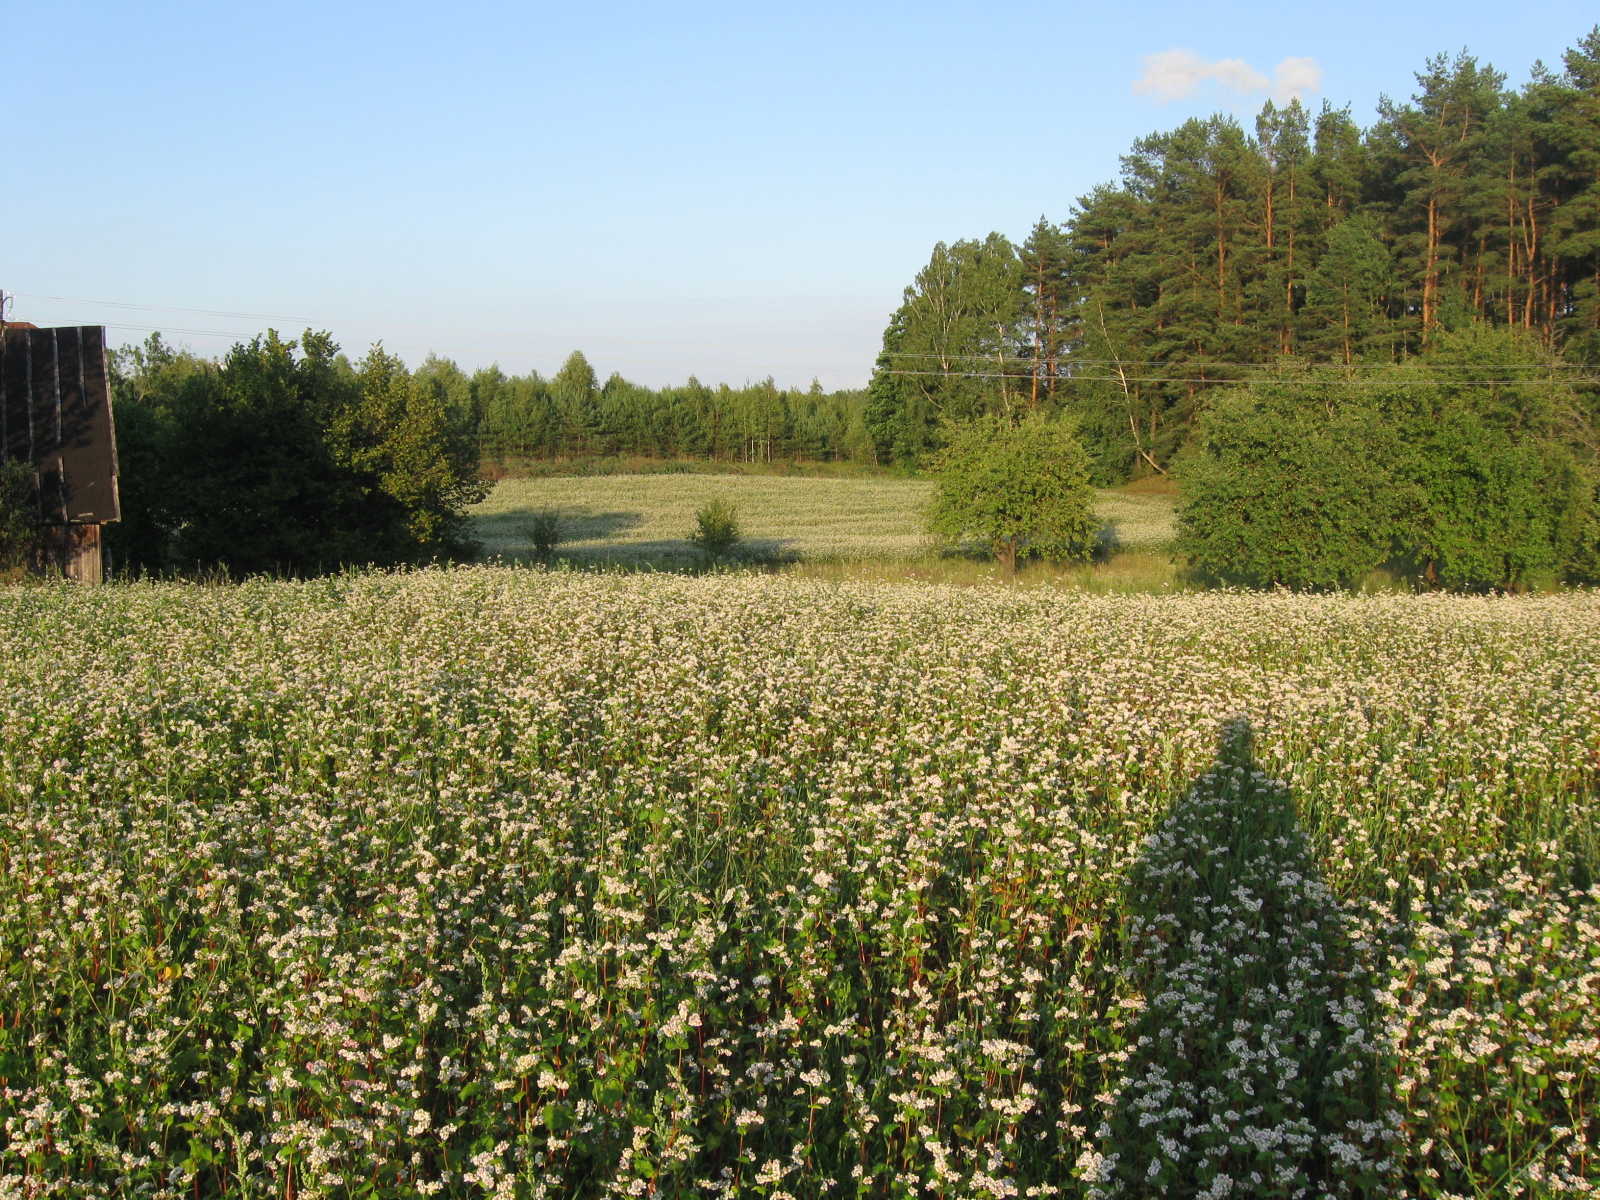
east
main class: Cropland
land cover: Other cereals
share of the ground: > 75 %
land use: Agriculture (excluding fallow land and kitchen gardens)
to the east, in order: Other cereals; Grassland without tree/shrub cover; Tracks; Electric lines; Grassland without tree/shrub cover; Apple fruit; Other cereals; Spontaneously vegetated surfaces; Pine dominated mixed woodland; Pine dominated coniferous woodland
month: July
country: LT
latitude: 54.0746
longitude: 23.7352
